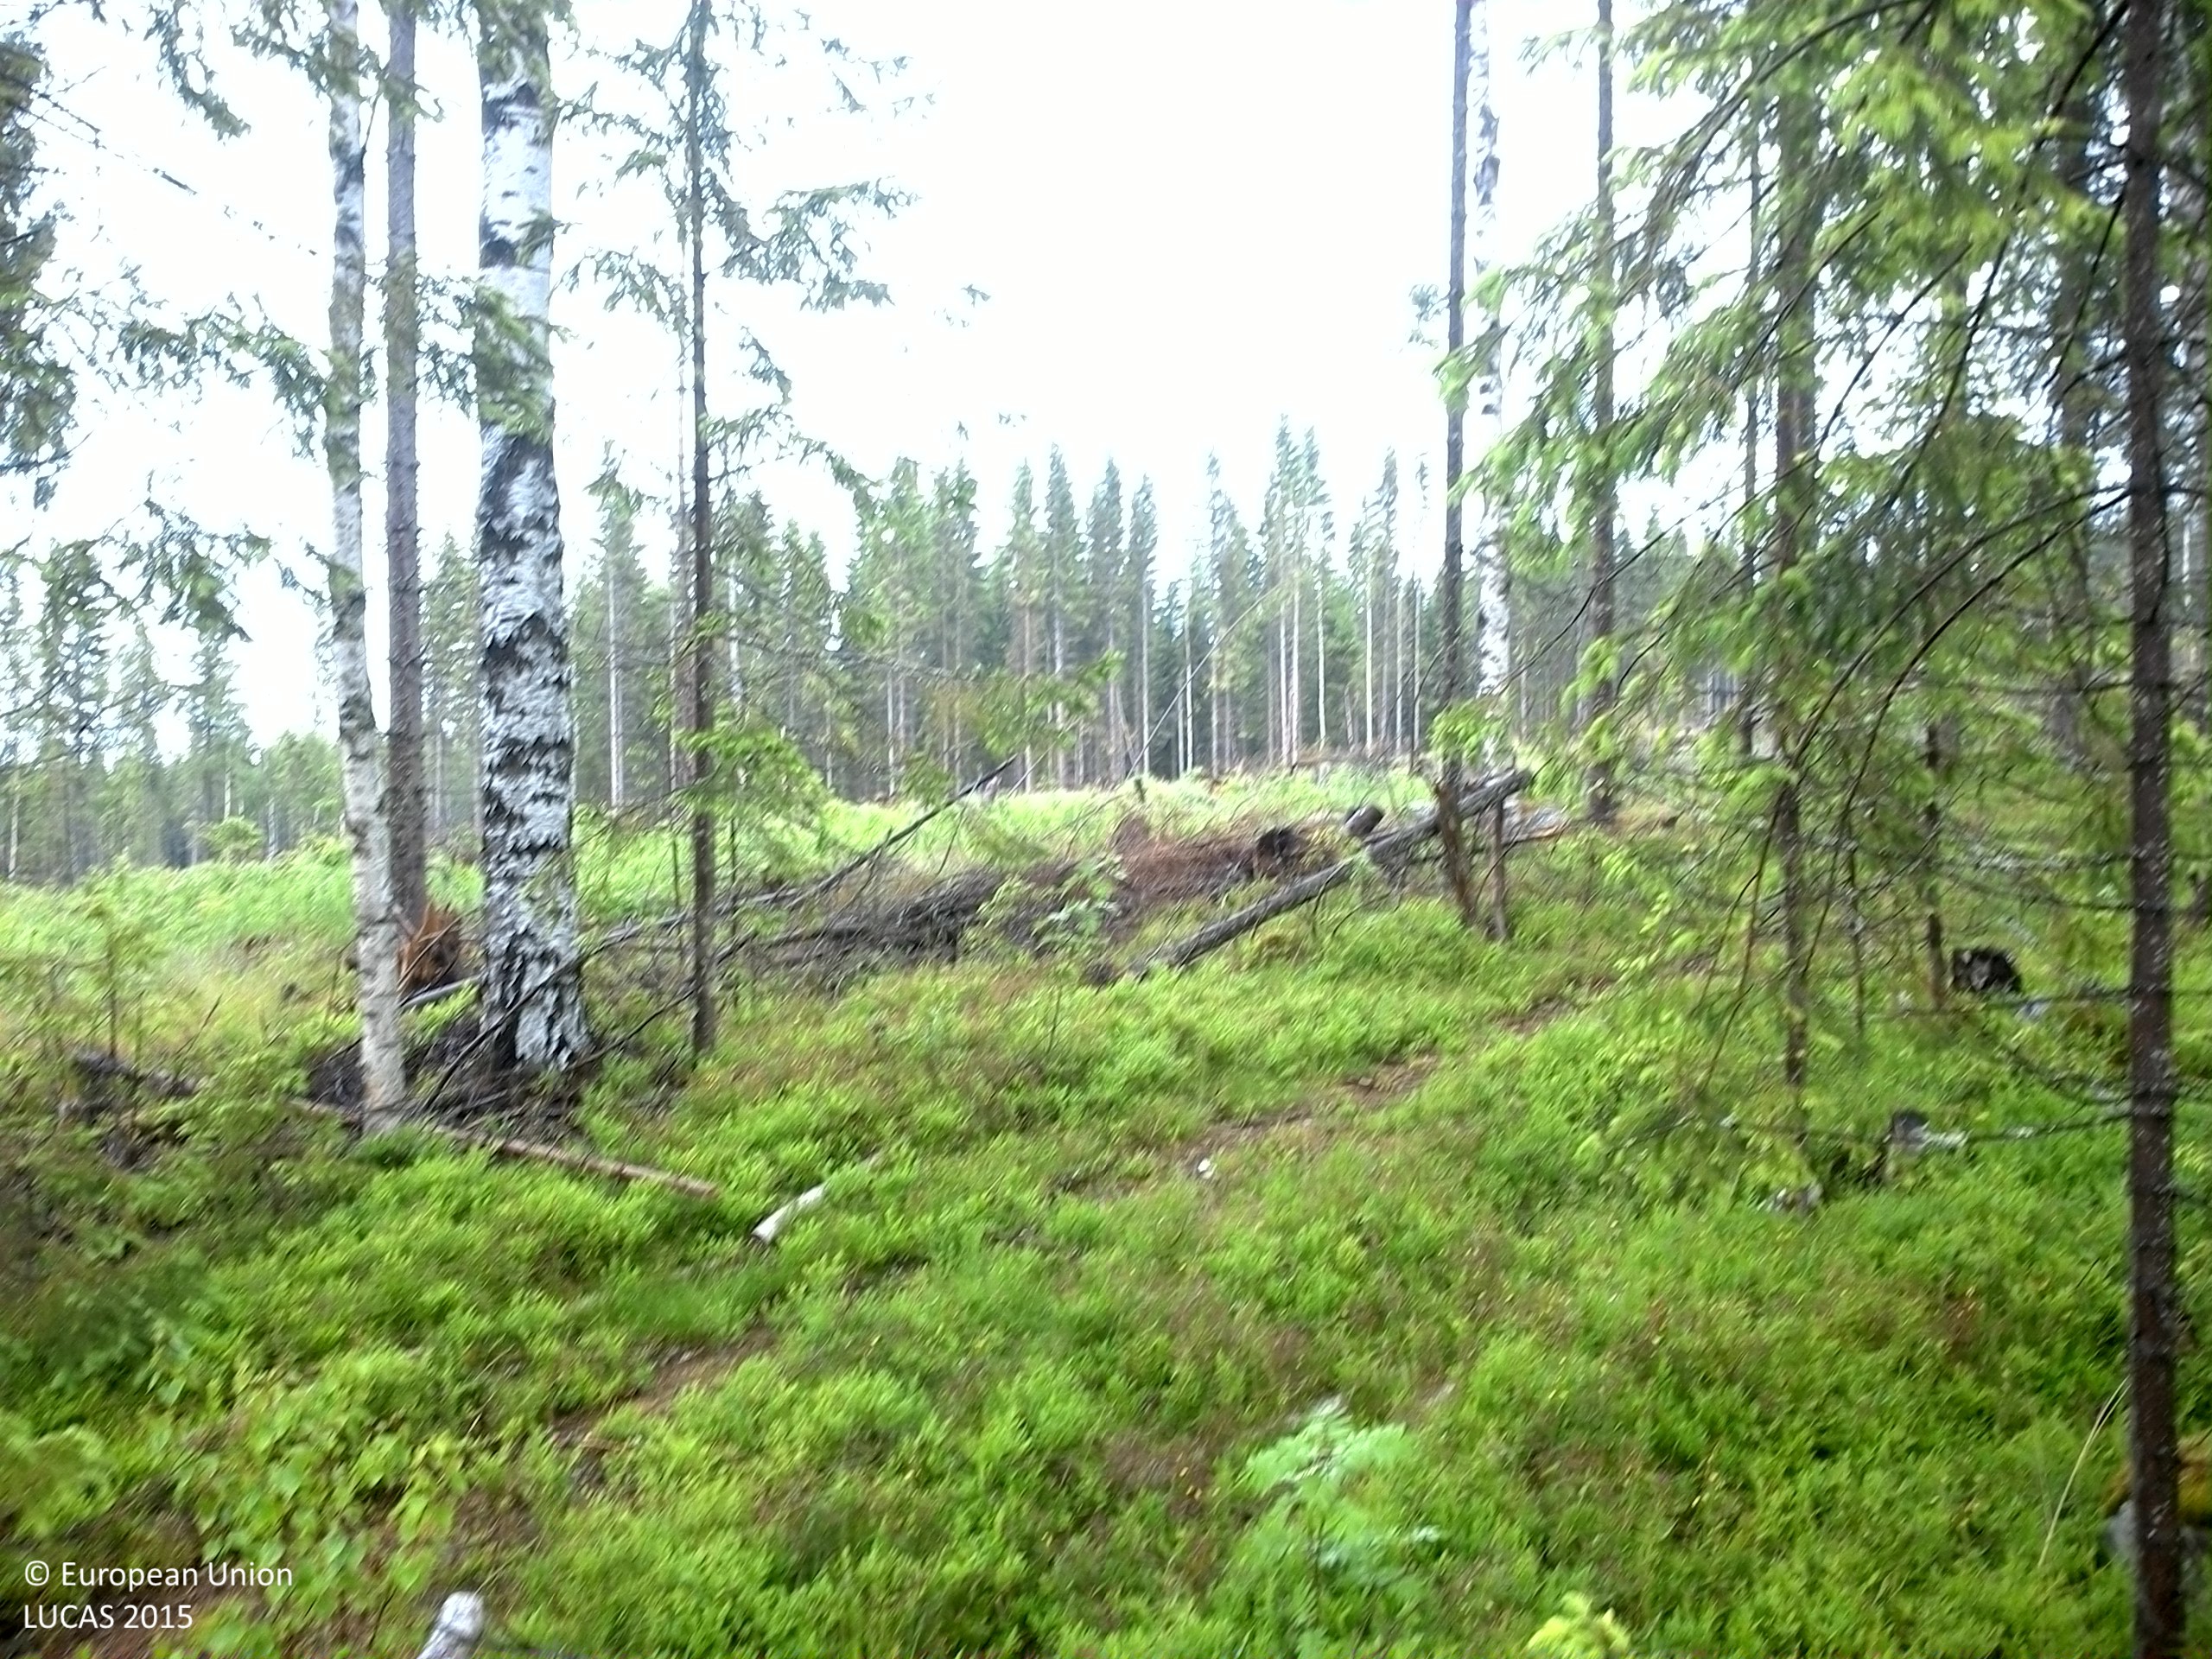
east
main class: Woodland
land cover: Spruce dominated mixed woodland
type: boreal forest
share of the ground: > 75 %
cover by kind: coniferous forest trees 60 %, broadleaved forest trees 20 %, shrubs 15 %, herbaceous plants 5 %
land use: Forestry
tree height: > 5 m
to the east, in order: Spruce dominated mixed woodland; Grassland with sparse tree/shrub cover; Spruce dominated coniferous woodland
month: June
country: SE
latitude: 62.7669
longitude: 17.9124
